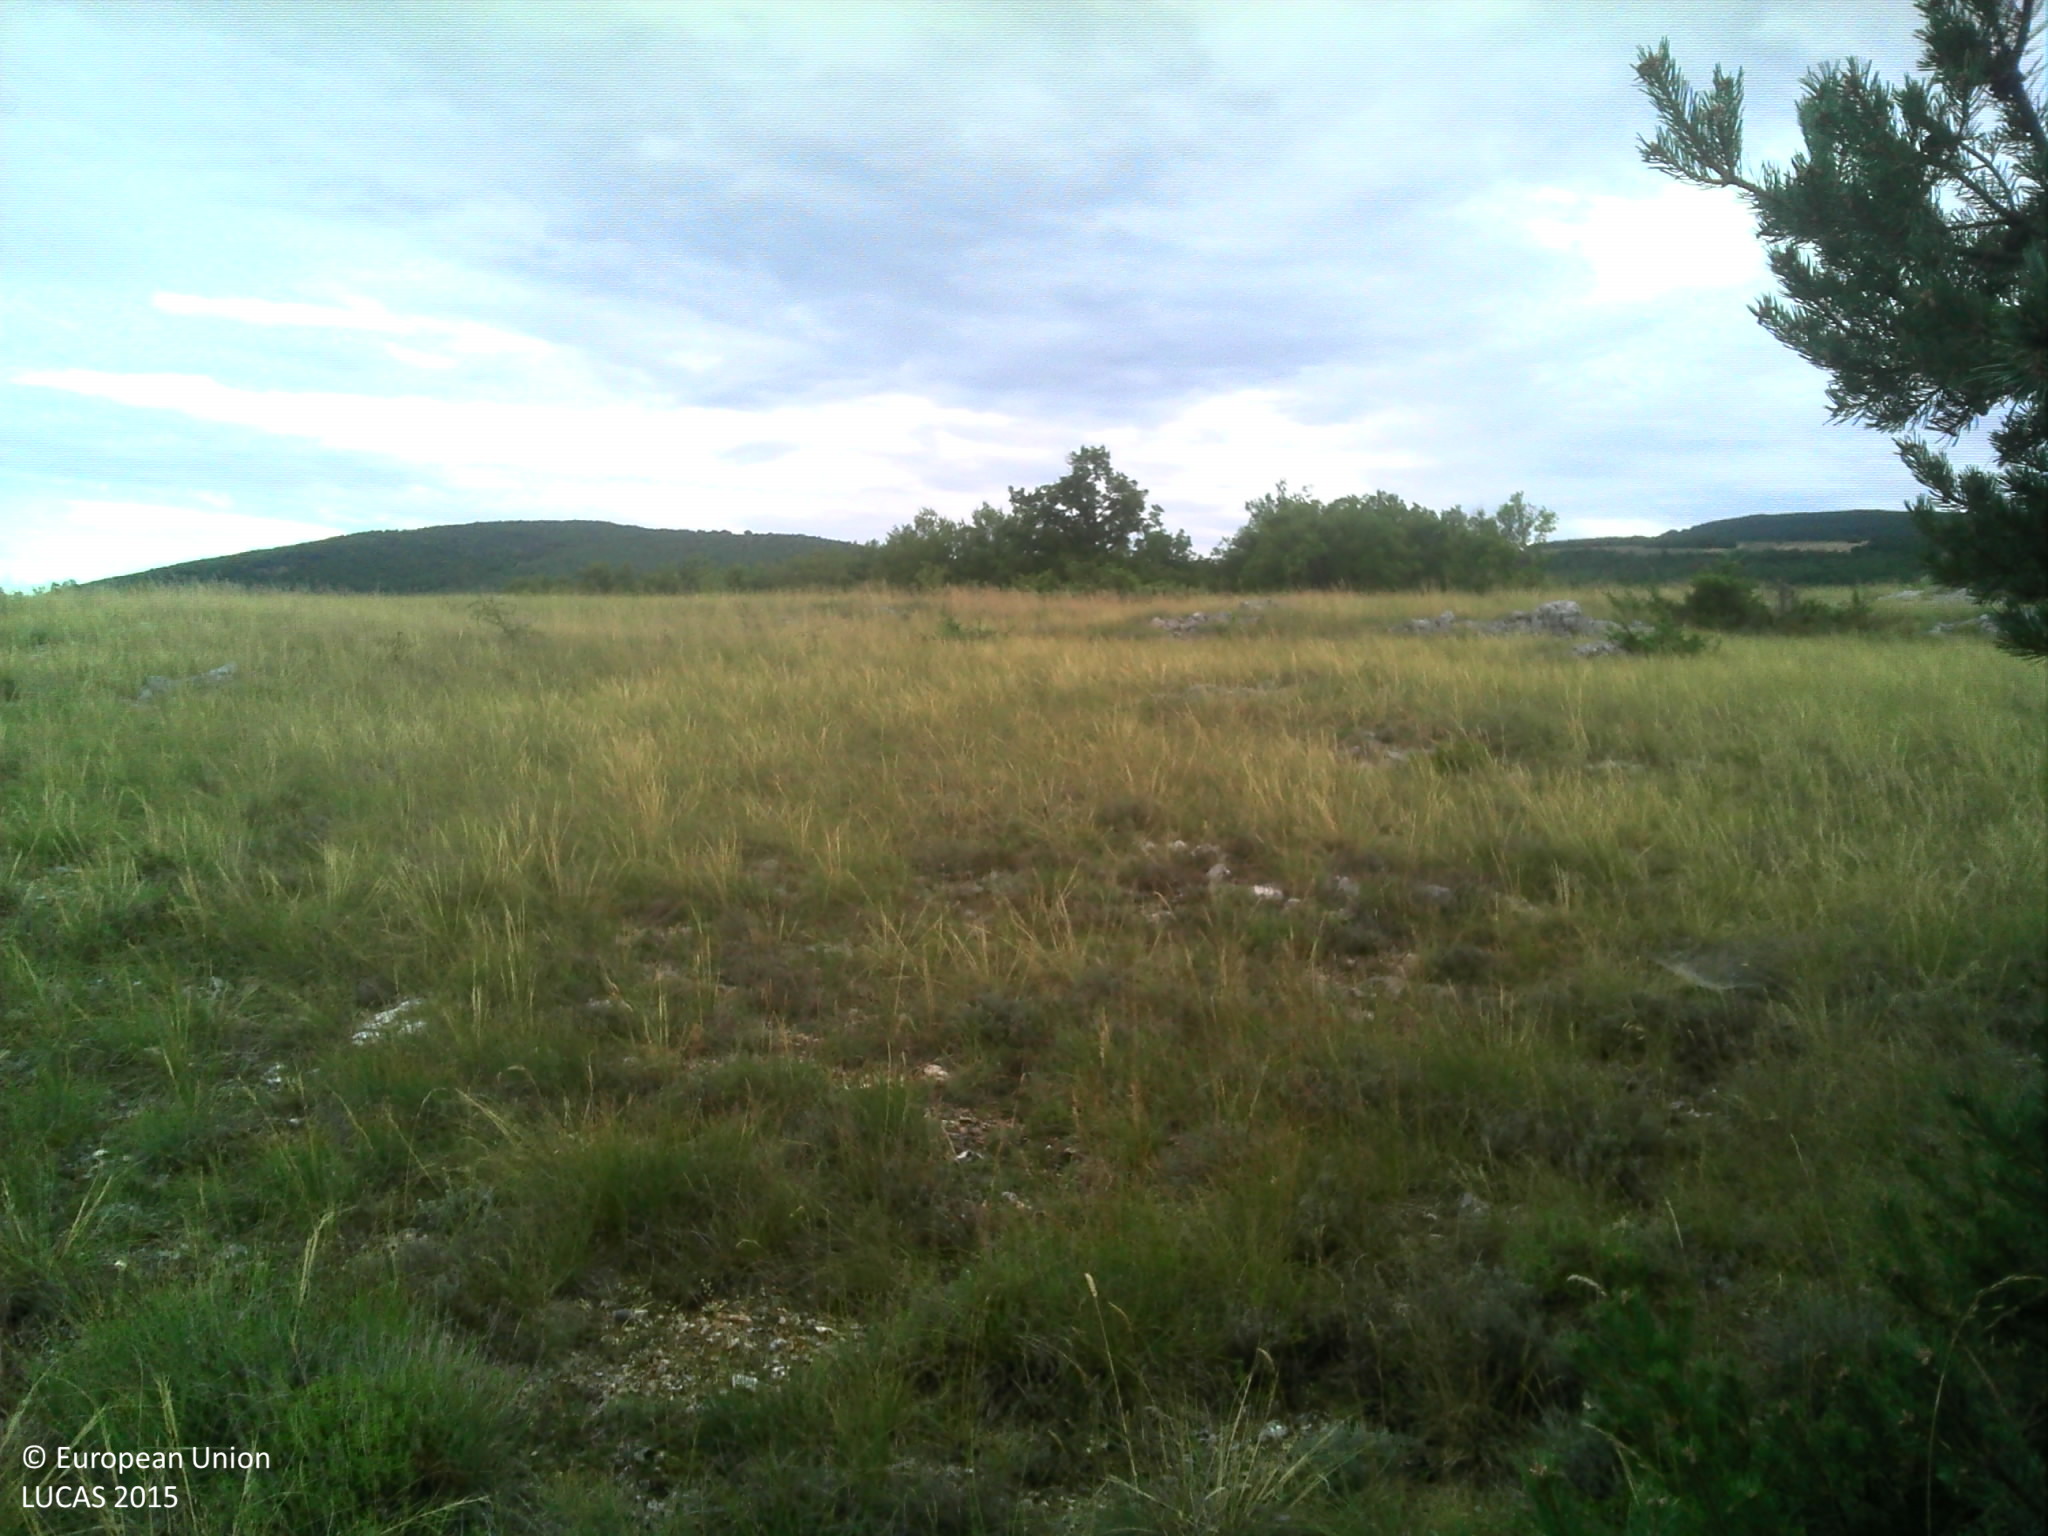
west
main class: Grassland
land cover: Grassland with sparse tree/shrub cover
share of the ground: > 75 %
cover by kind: herbaceous plants 75 %, consolidated bare surface 15 %, coniferous forest trees 5 %, shrubs 5 %
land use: Semi-natural and natural areas not in use
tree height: < 5 m
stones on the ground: 25 - 50 %
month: July
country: FR
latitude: 44.0014
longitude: 5.5311
